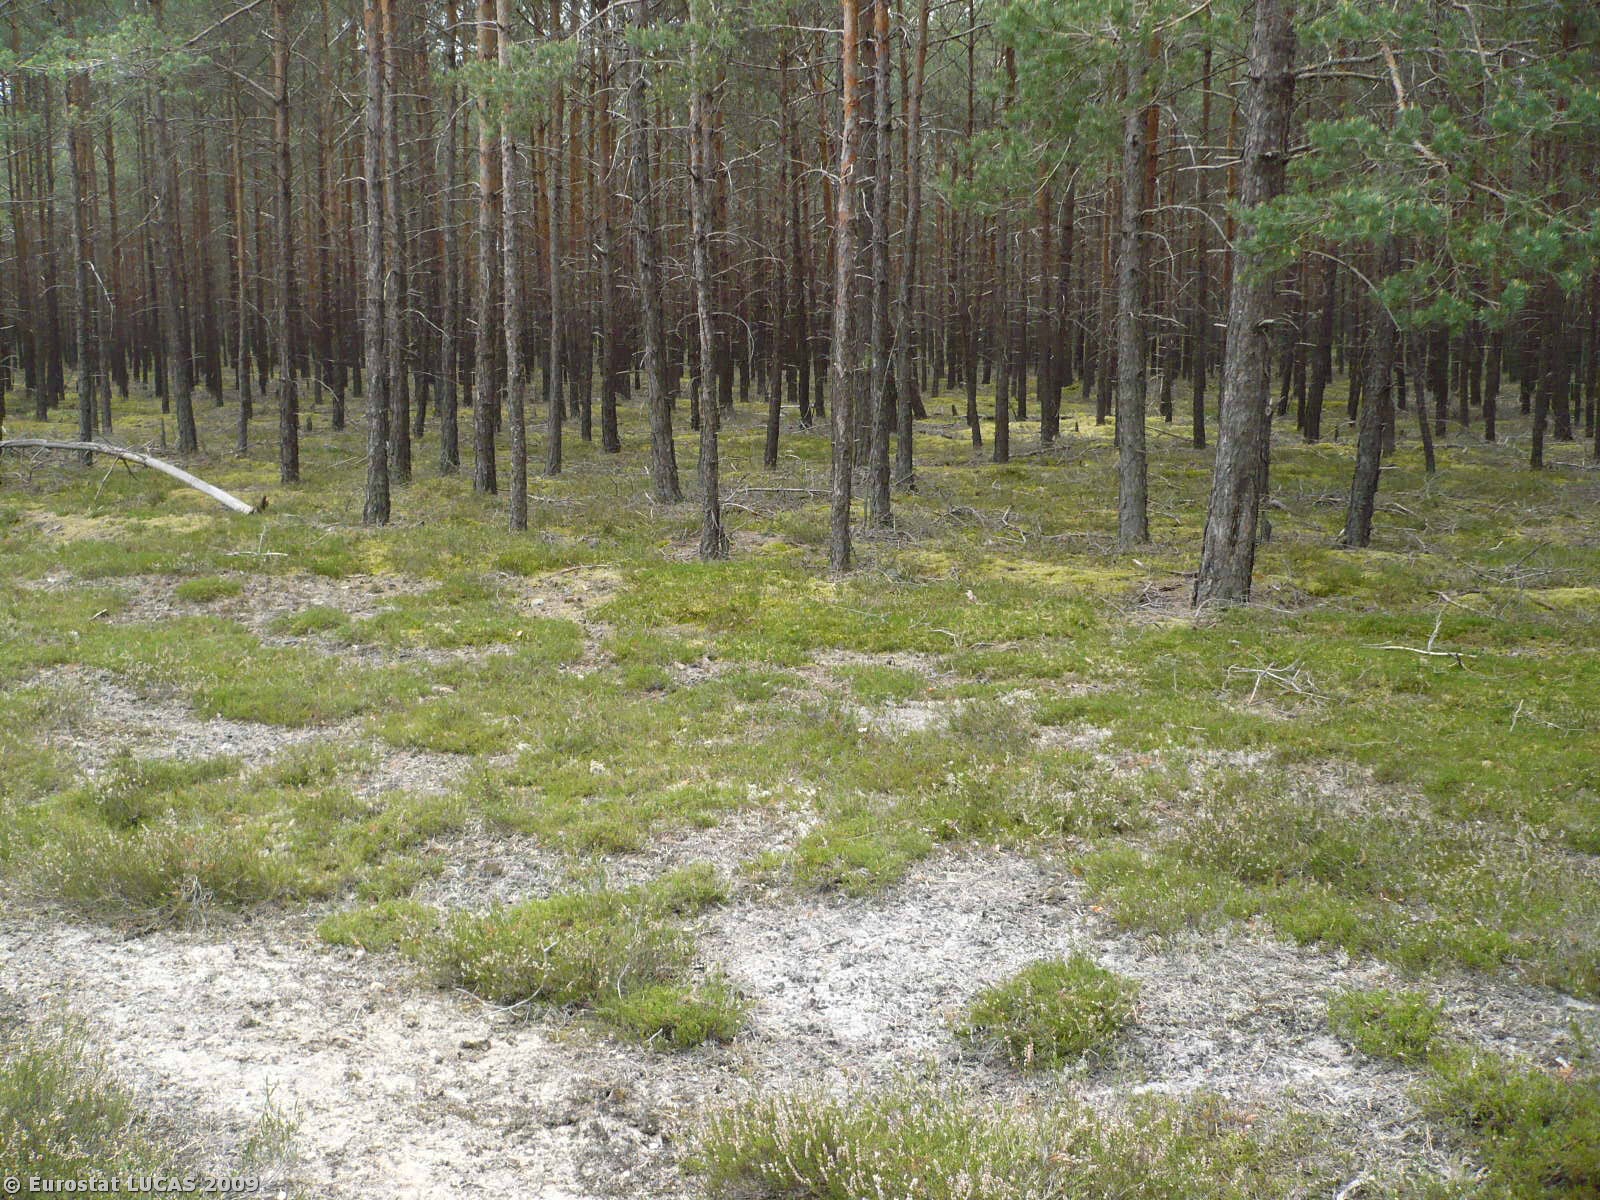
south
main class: Woodland
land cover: Coniferous woodland
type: hemiboreal forest and nemoral coniferous forest and mixed broadleaved-coniferous forest
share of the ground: 50 - 75 %
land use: Forestry
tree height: > 5 m
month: May
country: PL
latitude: 51.8704
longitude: 15.1300
